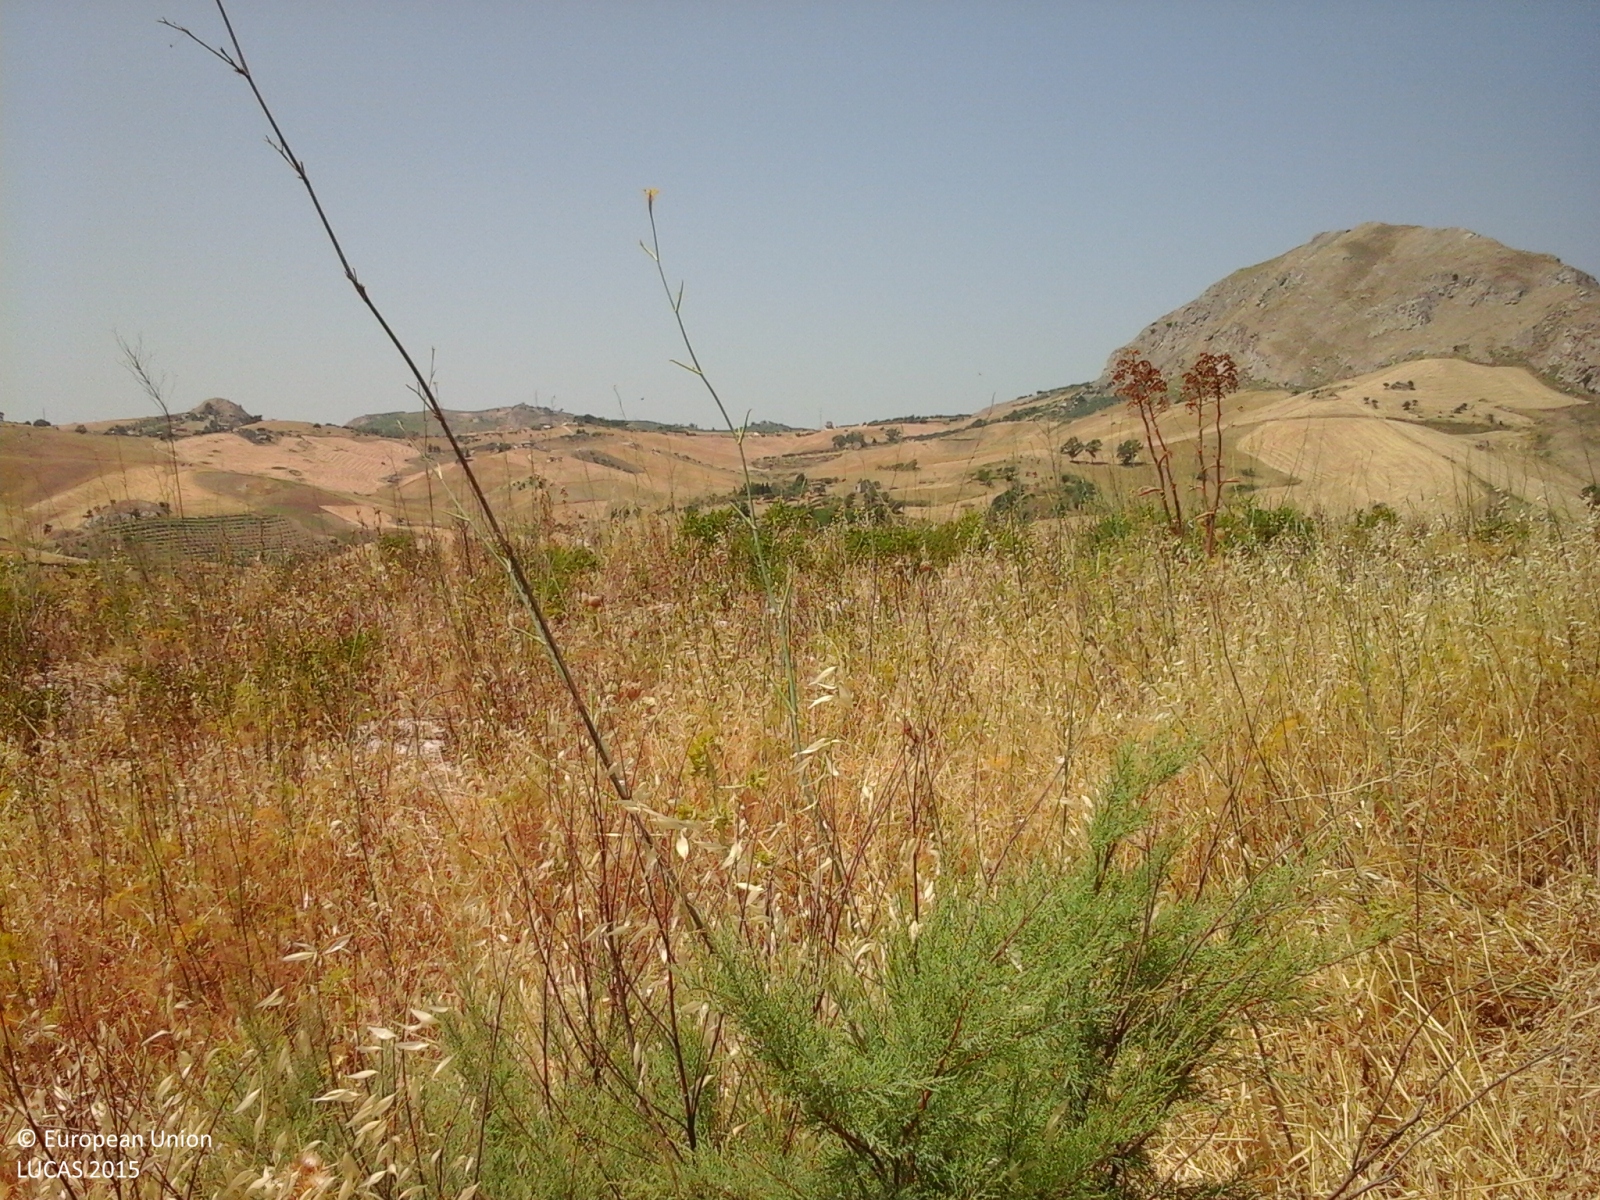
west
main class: Grassland
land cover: Spontaneously vegetated surfaces
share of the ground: > 75 %
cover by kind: herbaceous plants 100 %
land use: Agriculture (excluding fallow land and kitchen gardens)
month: July
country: IT
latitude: 37.4457
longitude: 13.5335
